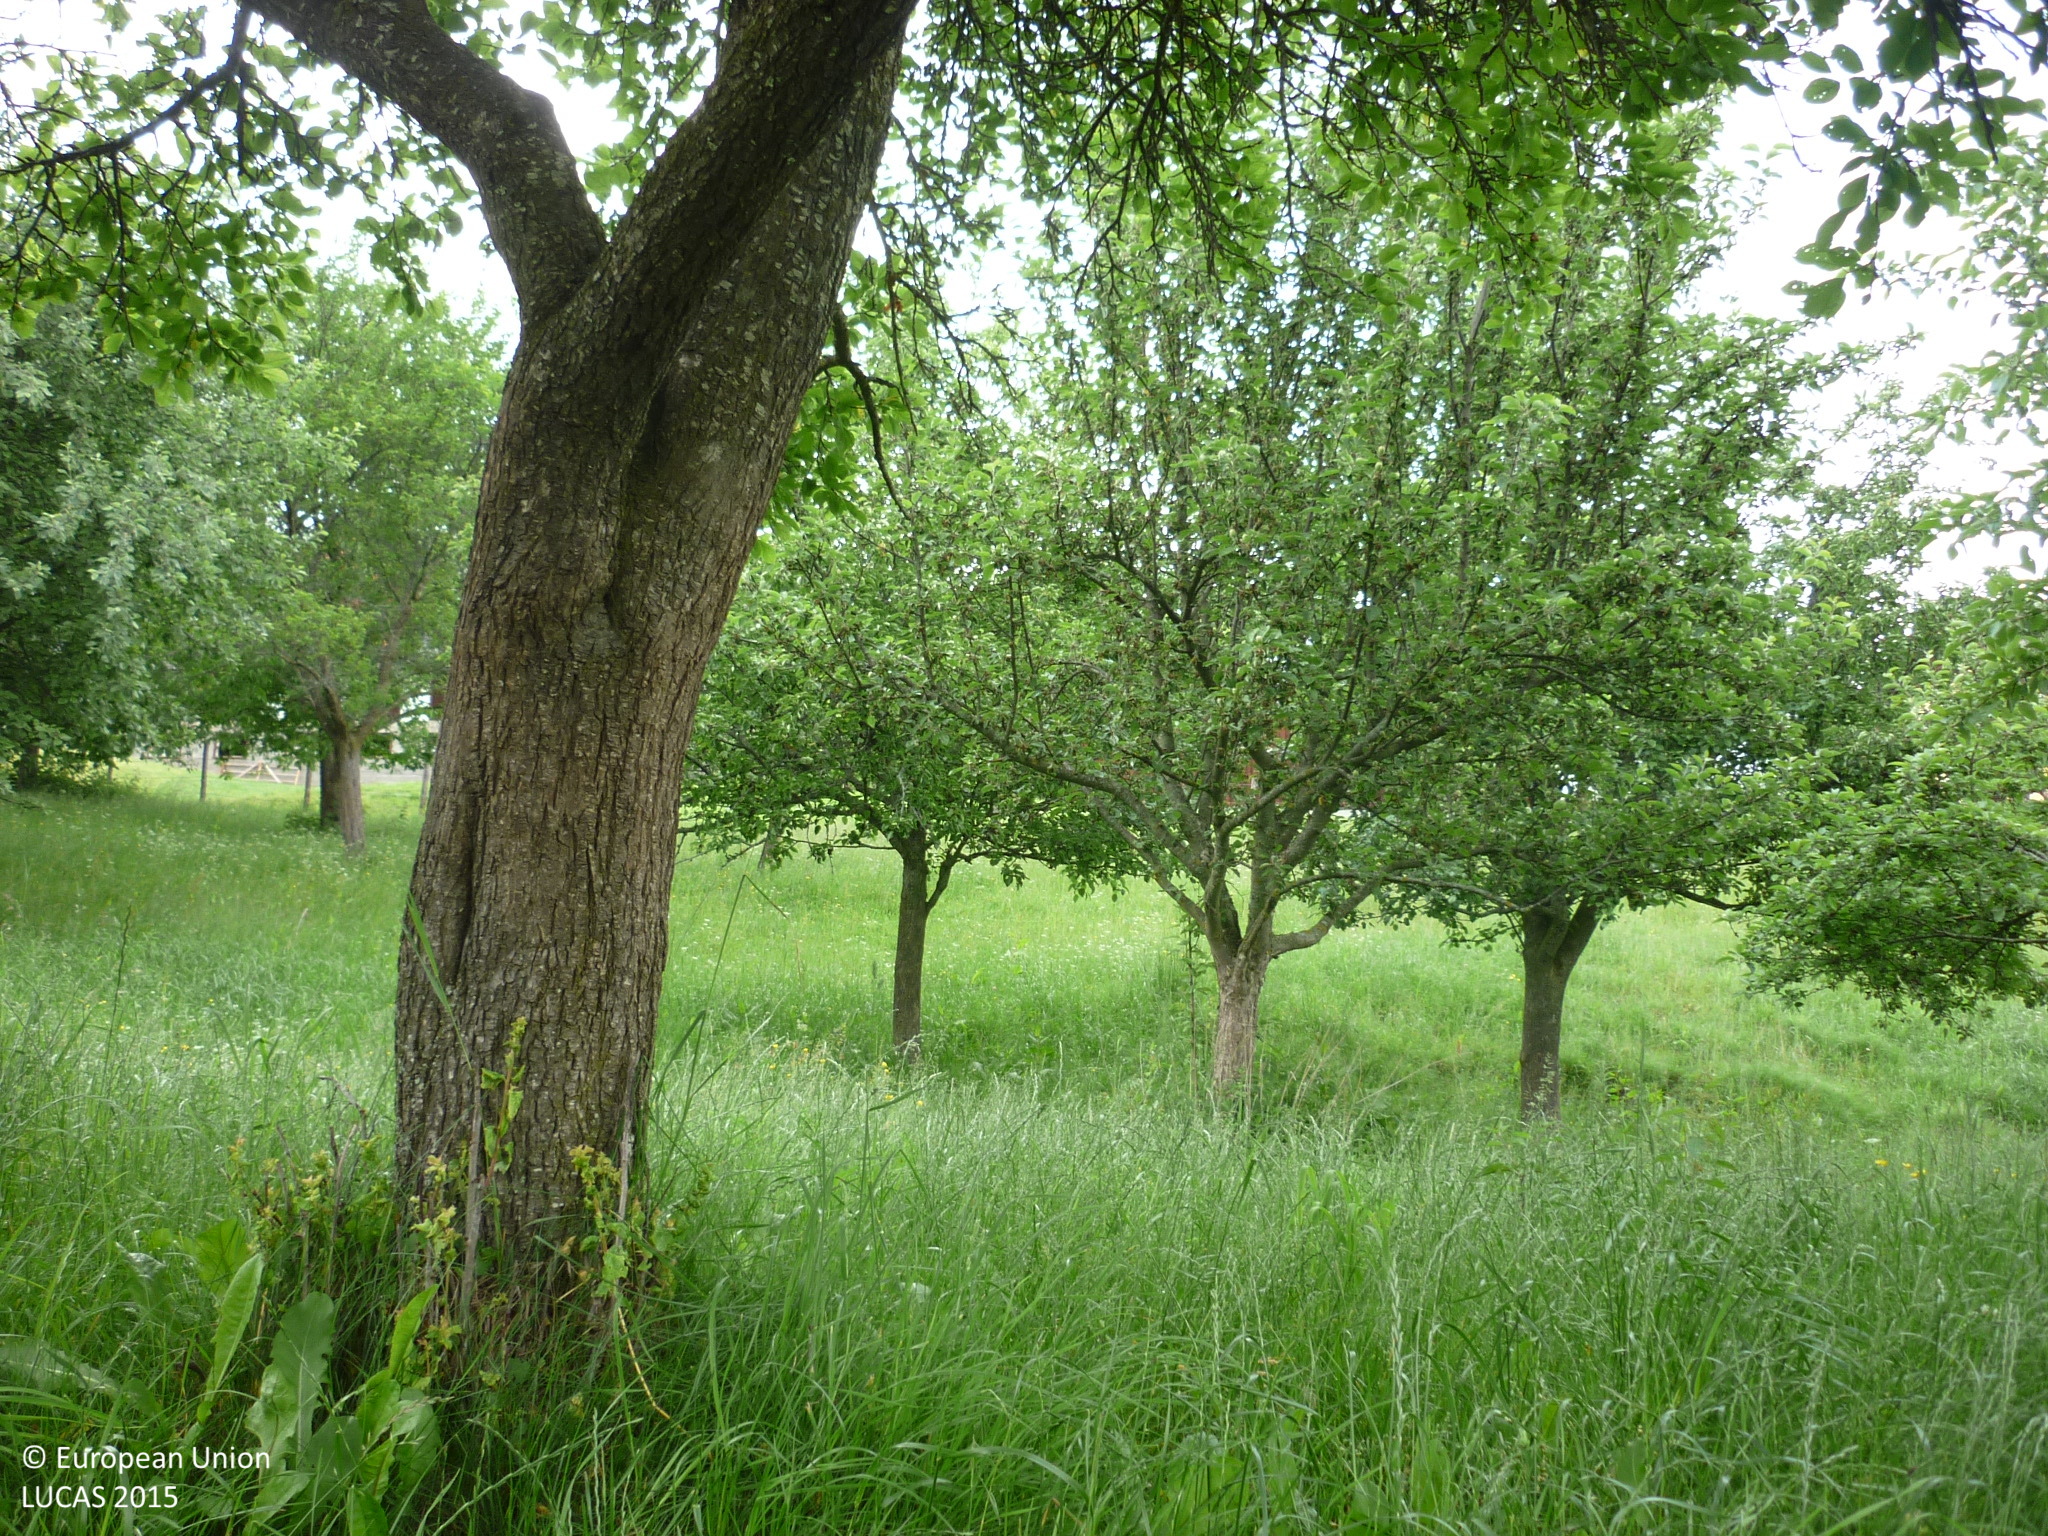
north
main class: Cropland
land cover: Other fruit trees and berries
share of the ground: 25 - 50 %
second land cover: Grassland without tree/shrub cover
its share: > 75 %
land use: Agriculture (excluding fallow land and kitchen gardens)
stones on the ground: 10 - 25 %
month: June
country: AT
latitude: 47.2070
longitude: 14.1834
